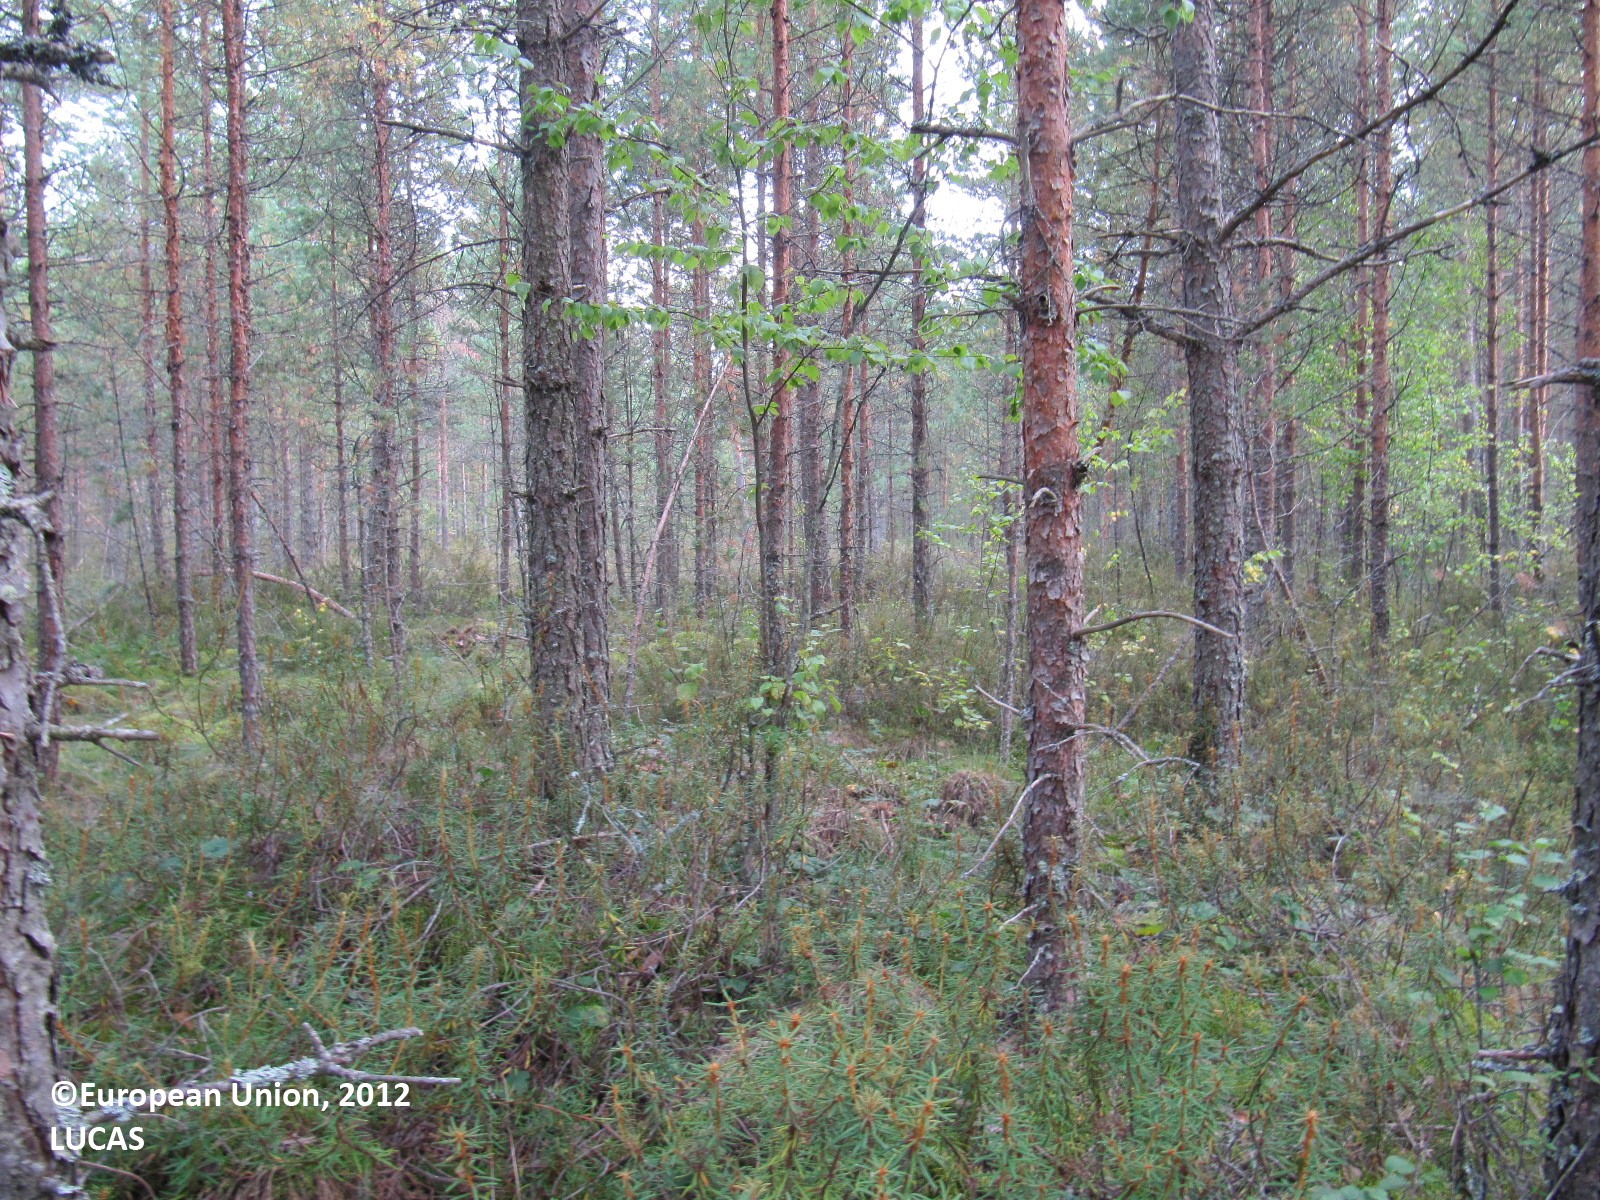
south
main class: Woodland
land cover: Pine dominated coniferous woodland
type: boreal forest
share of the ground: > 75 %
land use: Forestry
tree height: > 5 m
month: August
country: FI
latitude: 61.0617
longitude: 22.9495
